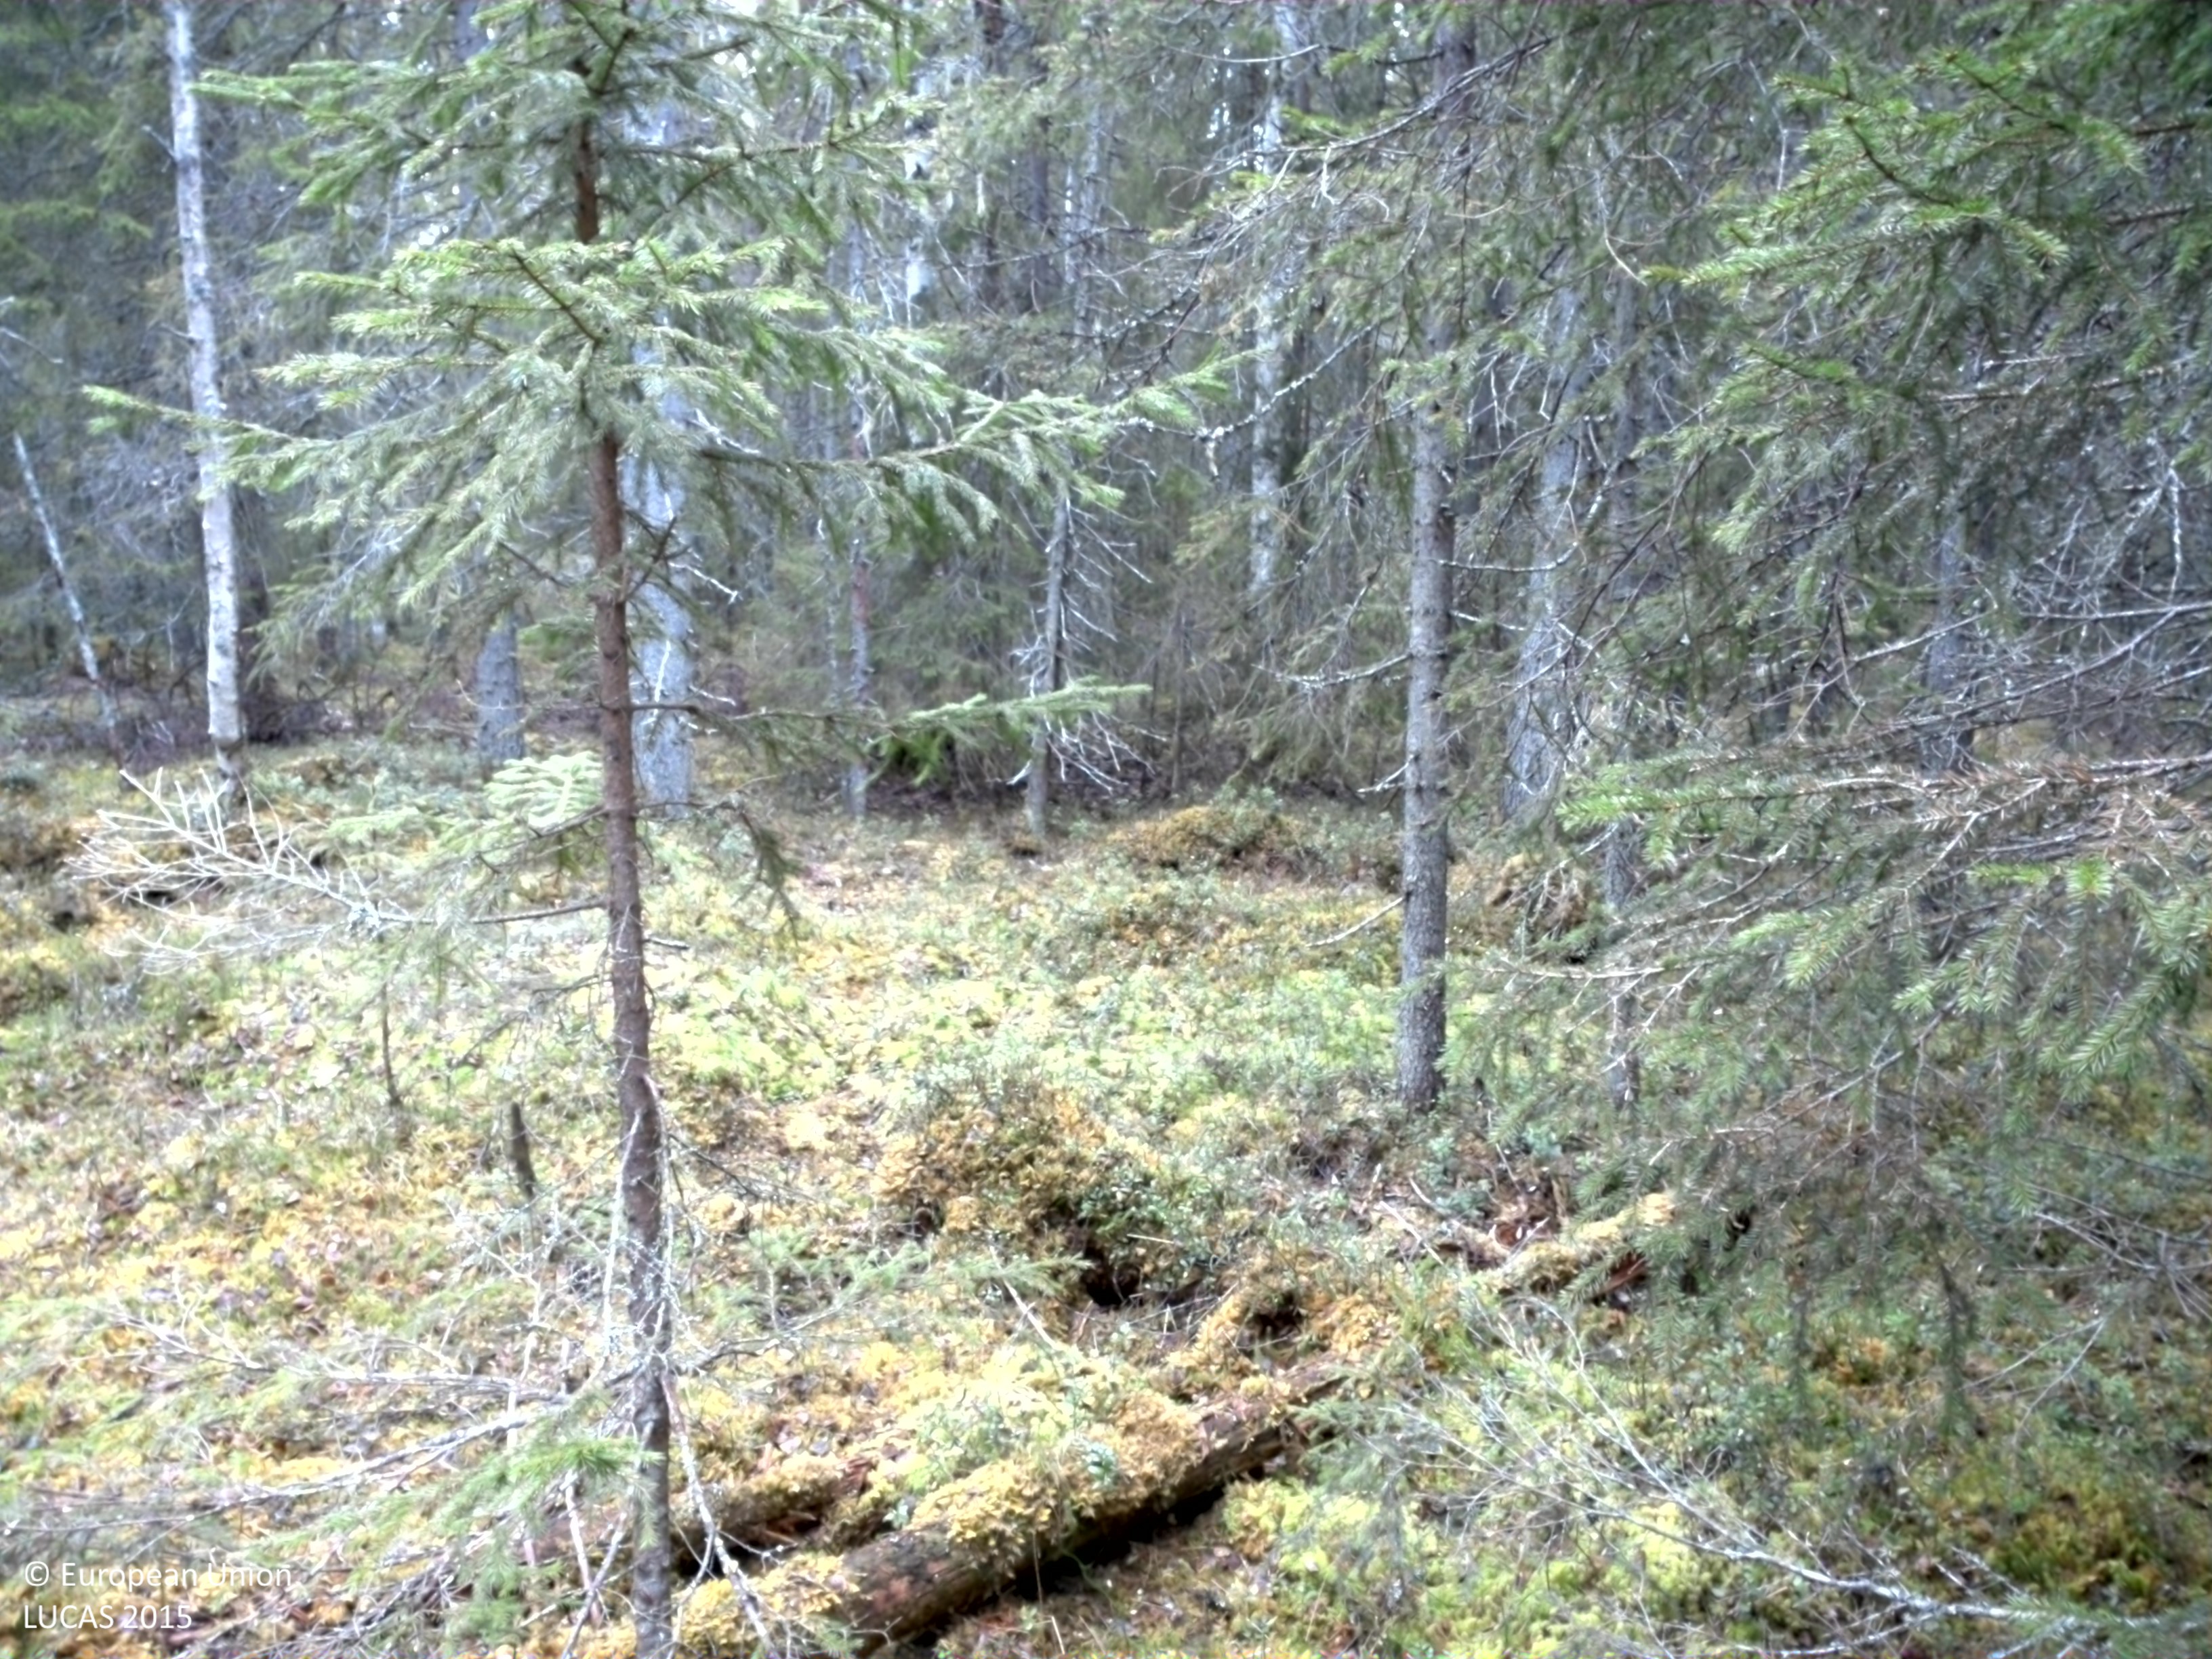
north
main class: Woodland
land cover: Spruce dominated coniferous woodland
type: boreal forest
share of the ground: > 75 %
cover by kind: coniferous forest trees 80 %, lichens and mosses 15 %, broadleaved forest trees 5 %
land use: Forestry
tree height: > 5 m
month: May
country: SE
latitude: 63.3598
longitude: 13.7591
